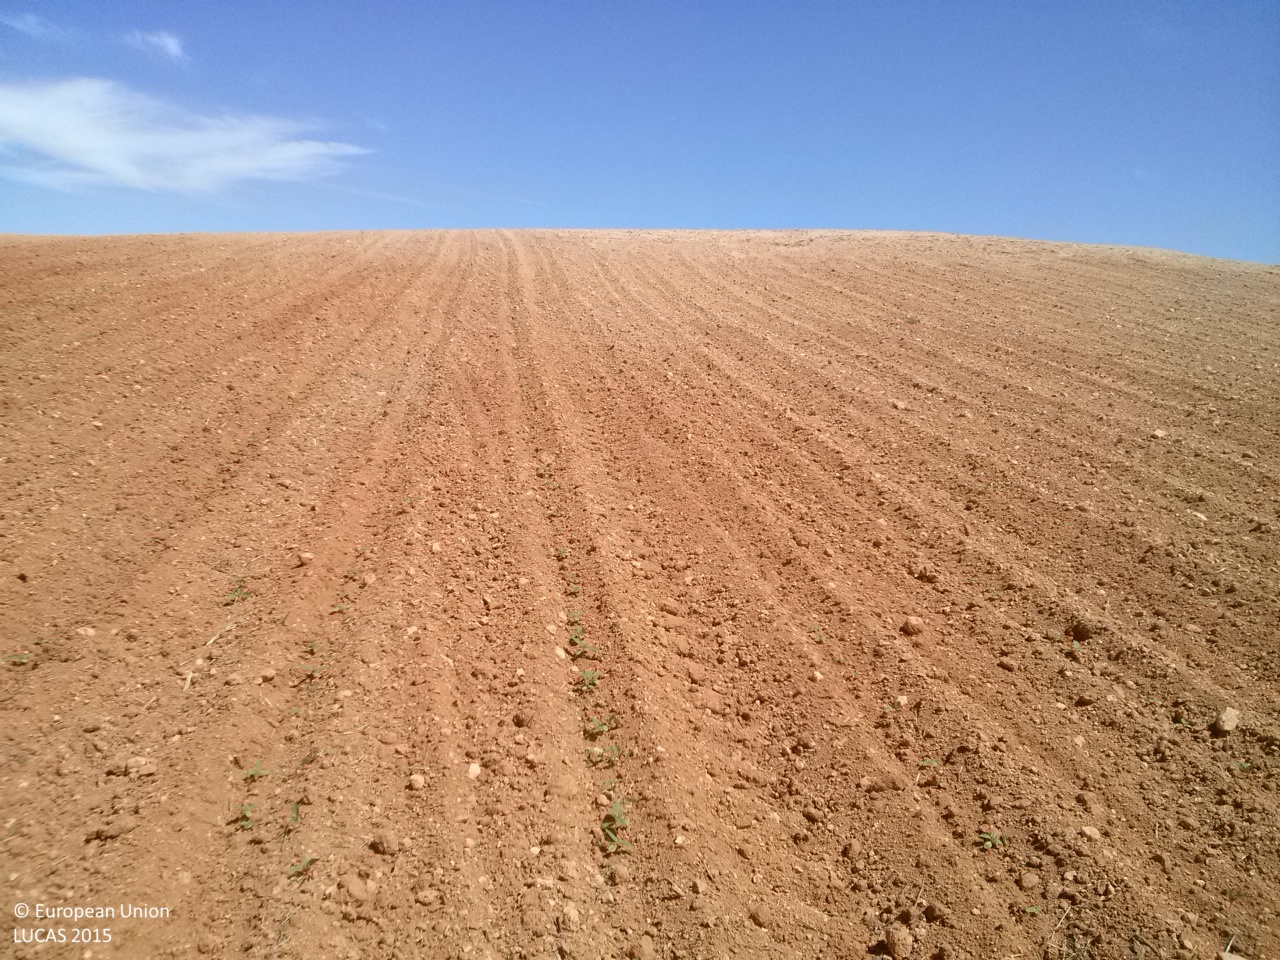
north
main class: Cropland
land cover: Sunflower
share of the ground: < 10 %
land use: Agriculture (excluding fallow land and kitchen gardens)
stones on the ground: < 10 %
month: May
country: ES
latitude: 40.0010
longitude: -2.8719
